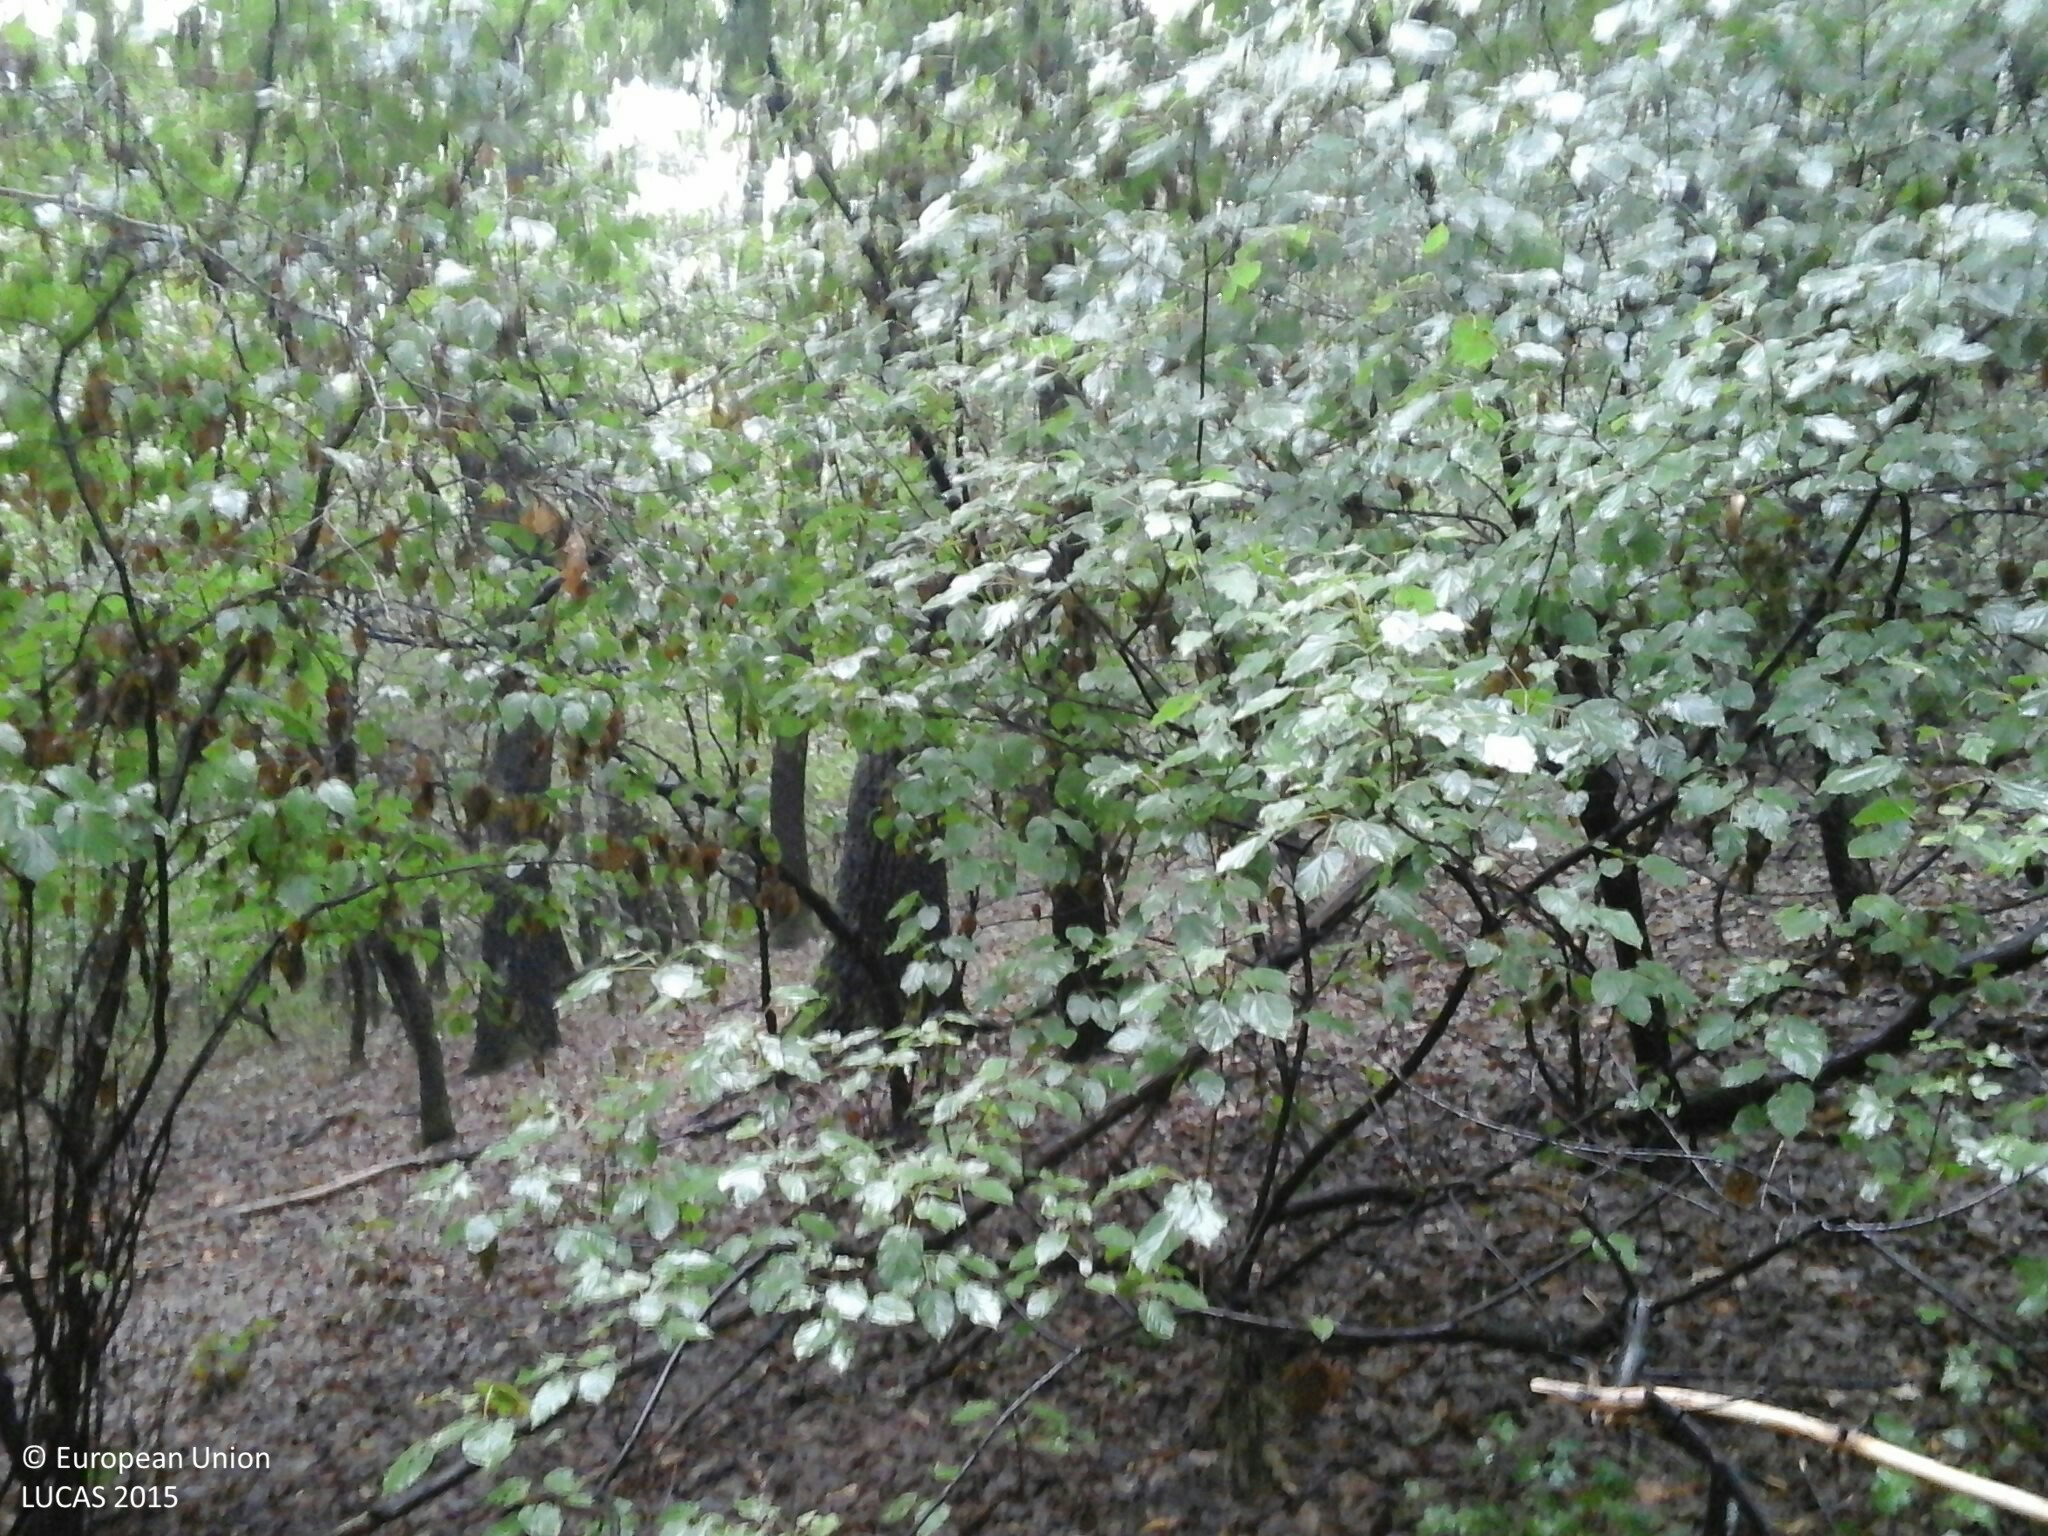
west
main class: Woodland
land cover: Broadleaved woodland
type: acidophilous oak and oak-birch forest
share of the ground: > 75 %
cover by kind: broadleaved forest trees 100 %
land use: Forestry
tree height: > 5 m
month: August
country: HU
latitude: 47.9723
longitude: 20.7115
